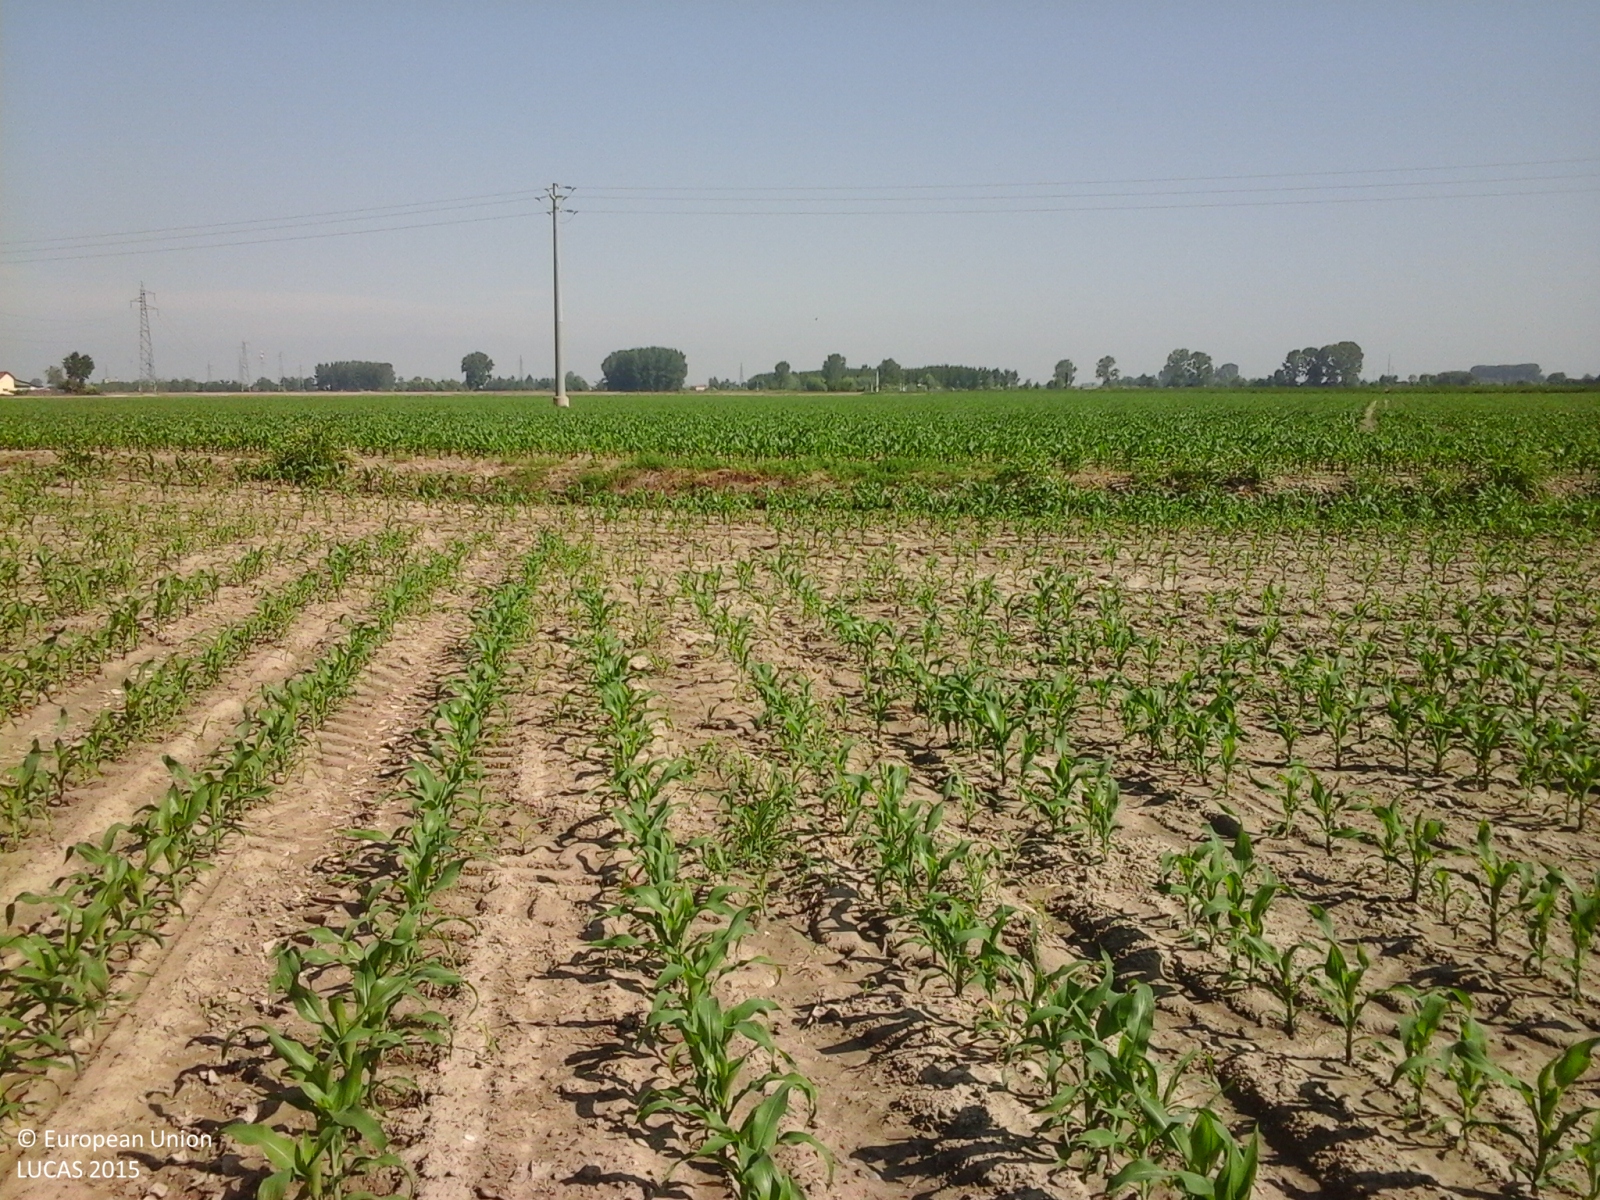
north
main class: Cropland
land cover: Maize
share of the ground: 25 - 50 %
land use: Agriculture (excluding fallow land and kitchen gardens)
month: May
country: IT
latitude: 45.1684
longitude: 8.4379
